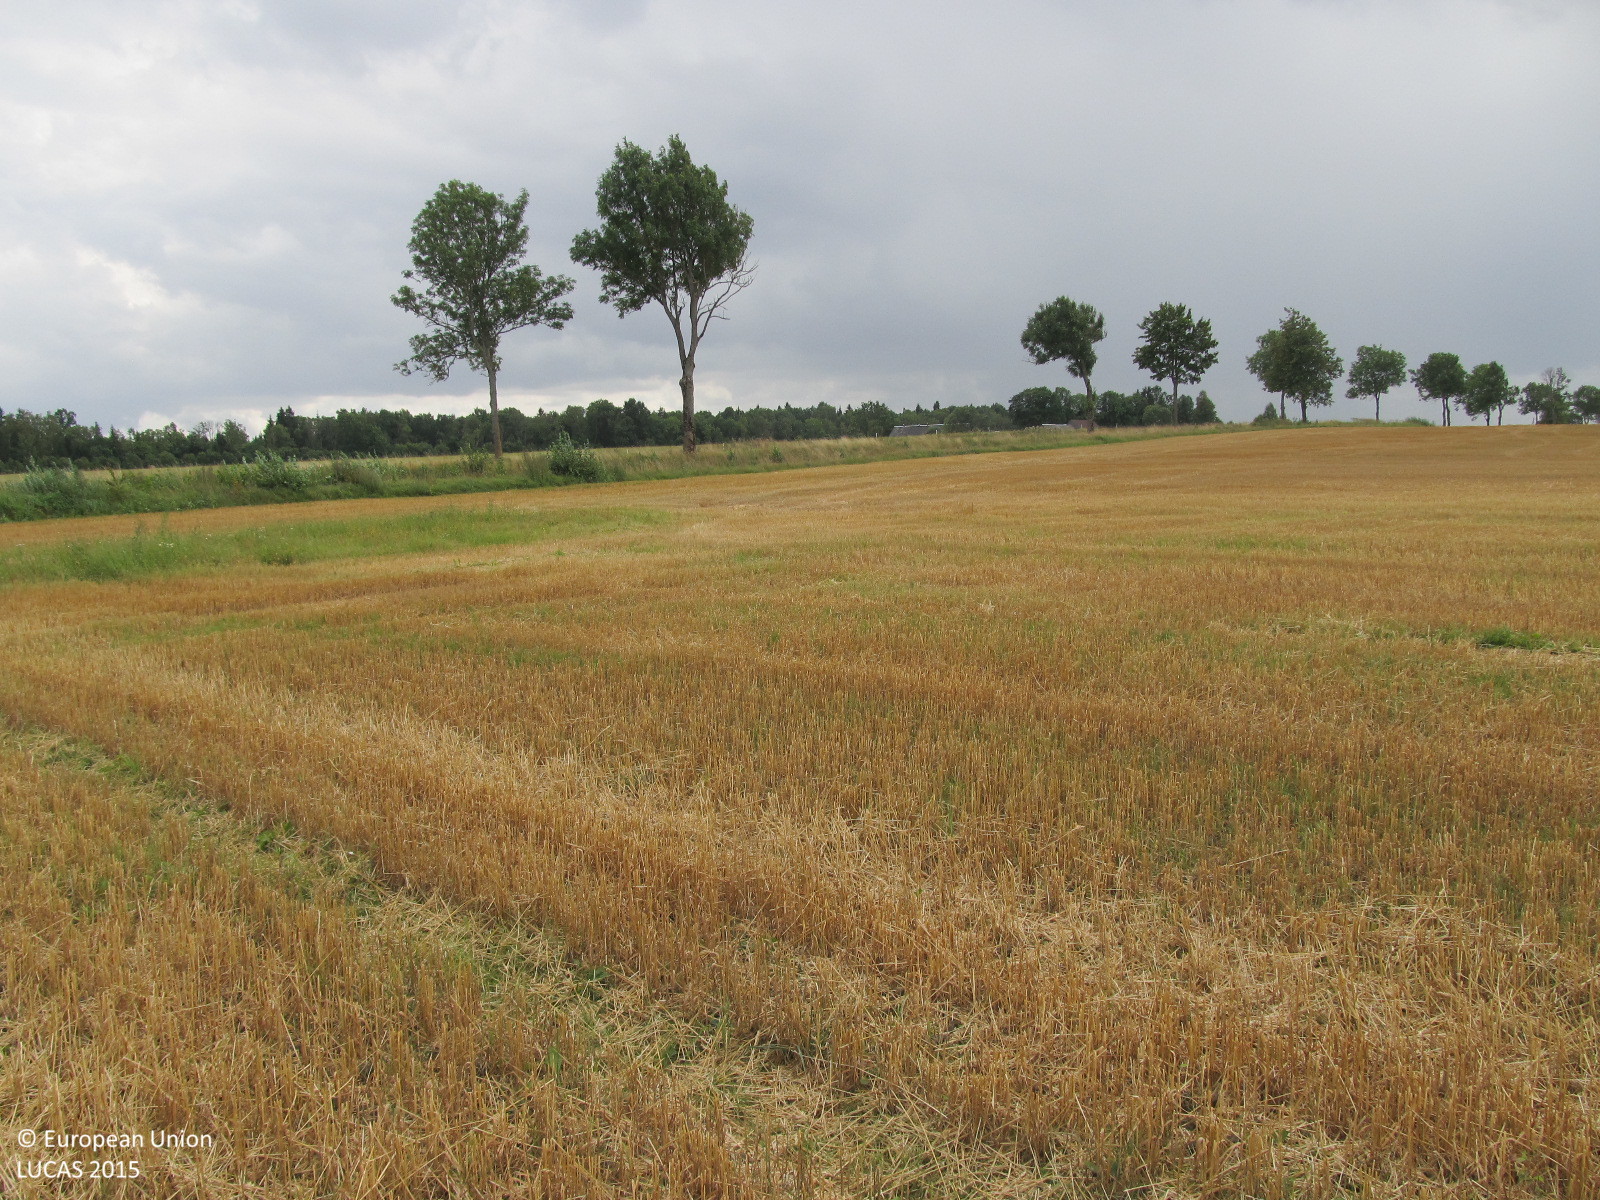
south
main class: Cropland
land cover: Common wheat
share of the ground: > 75 %
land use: Agriculture (excluding fallow land and kitchen gardens)
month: August
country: LT
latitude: 55.6868
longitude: 23.0008
